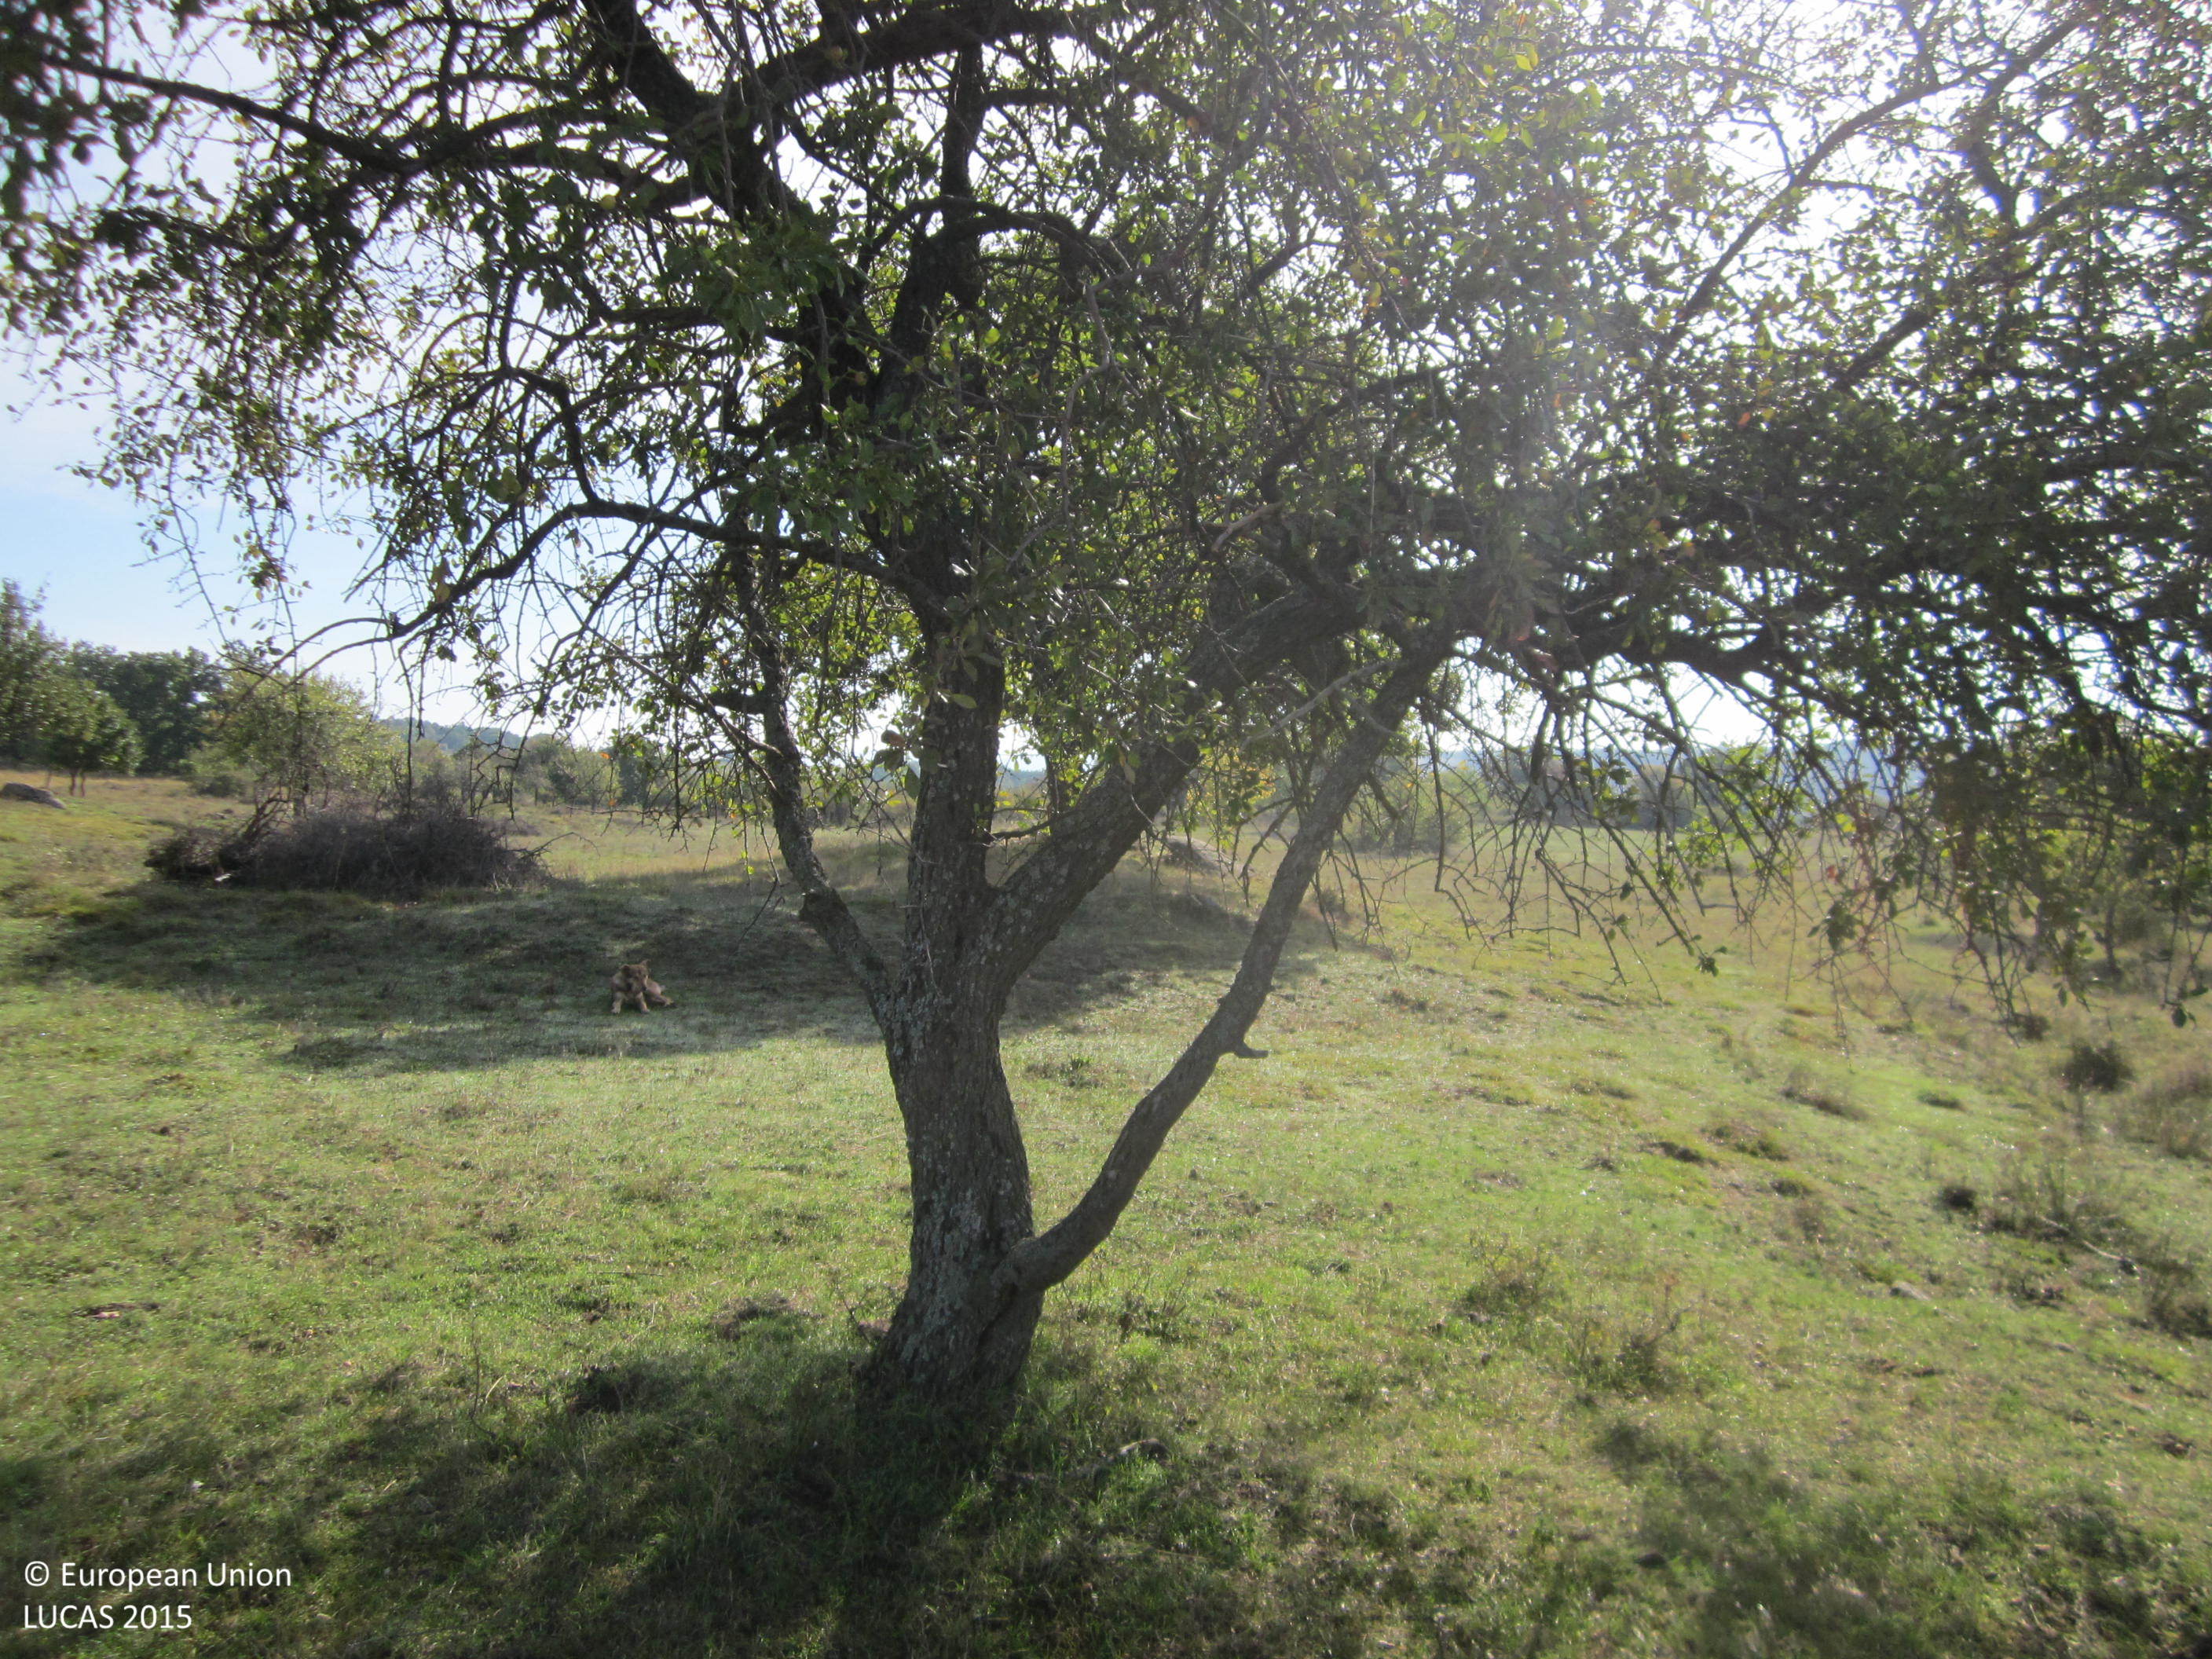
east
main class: Grassland
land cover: Grassland with sparse tree/shrub cover
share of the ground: > 75 %
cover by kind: herbaceous plants 90 %, broadleaved forest trees 5 %, shrubs 5 %
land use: Agriculture (excluding fallow land and kitchen gardens)
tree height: > 5 m
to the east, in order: Grassland with sparse tree/shrub cover; Tracks; Grassland with sparse tree/shrub cover
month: October
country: BG
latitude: 42.8768
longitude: 26.6901
